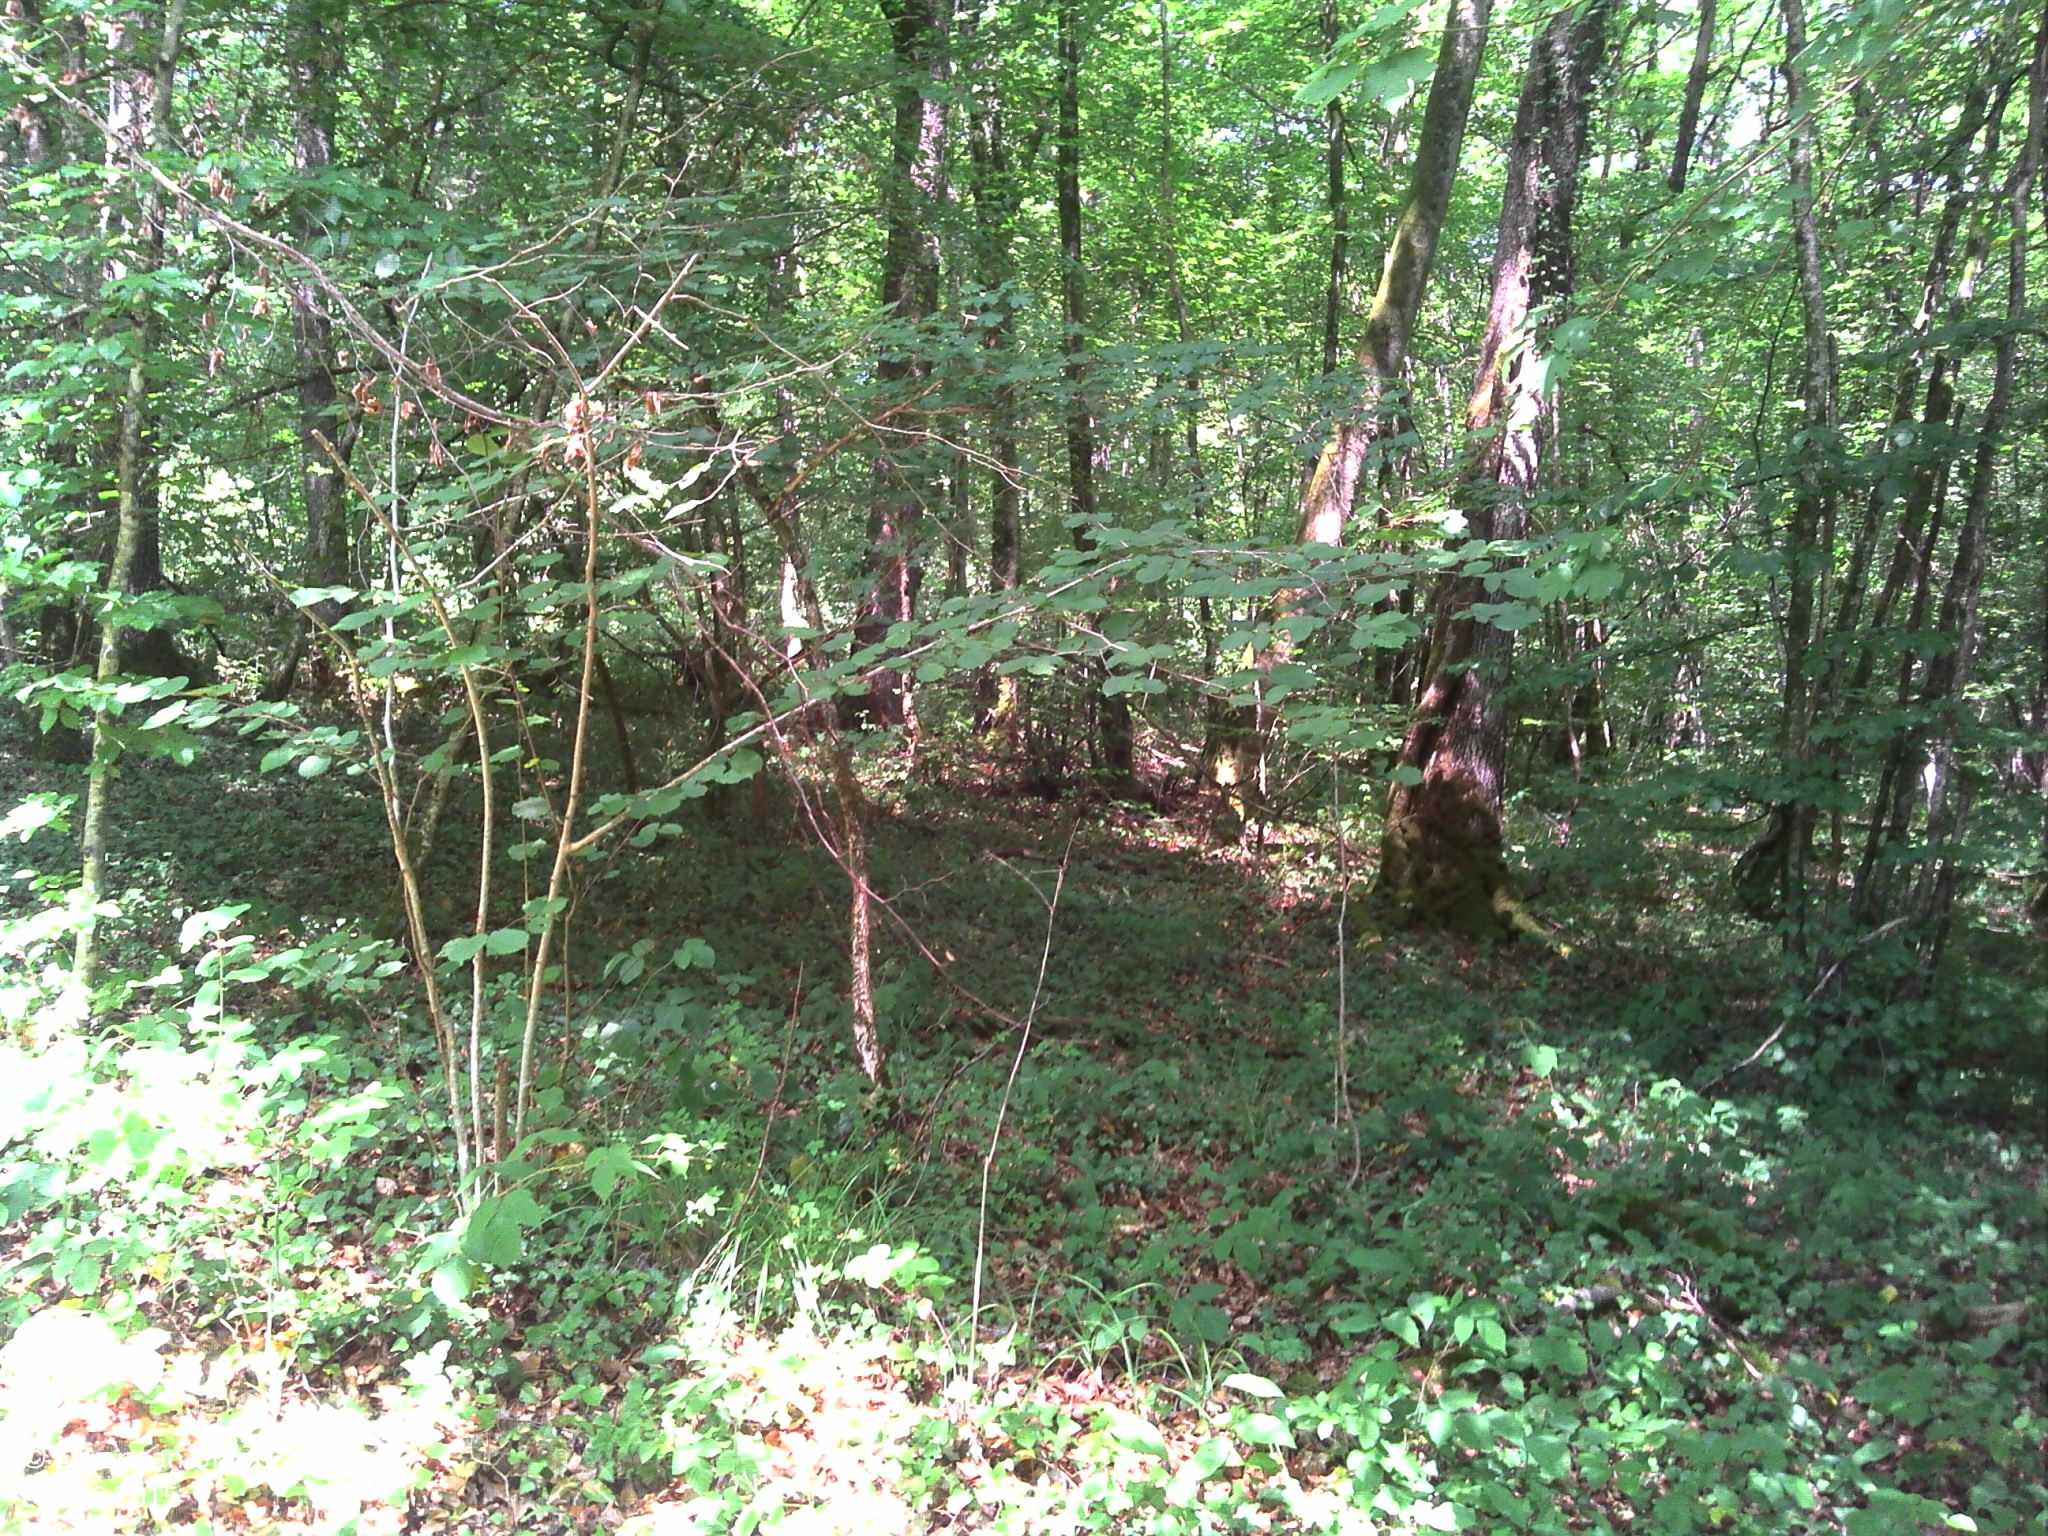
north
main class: Woodland
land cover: Broadleaved woodland
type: beech forest
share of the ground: > 75 %
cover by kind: broadleaved forest trees 85 %, lichens and mosses 10 %, herbaceous plants 5 %
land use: Forestry
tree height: > 5 m
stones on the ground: < 10 %
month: July
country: FR
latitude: 48.1214
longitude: 4.8534
